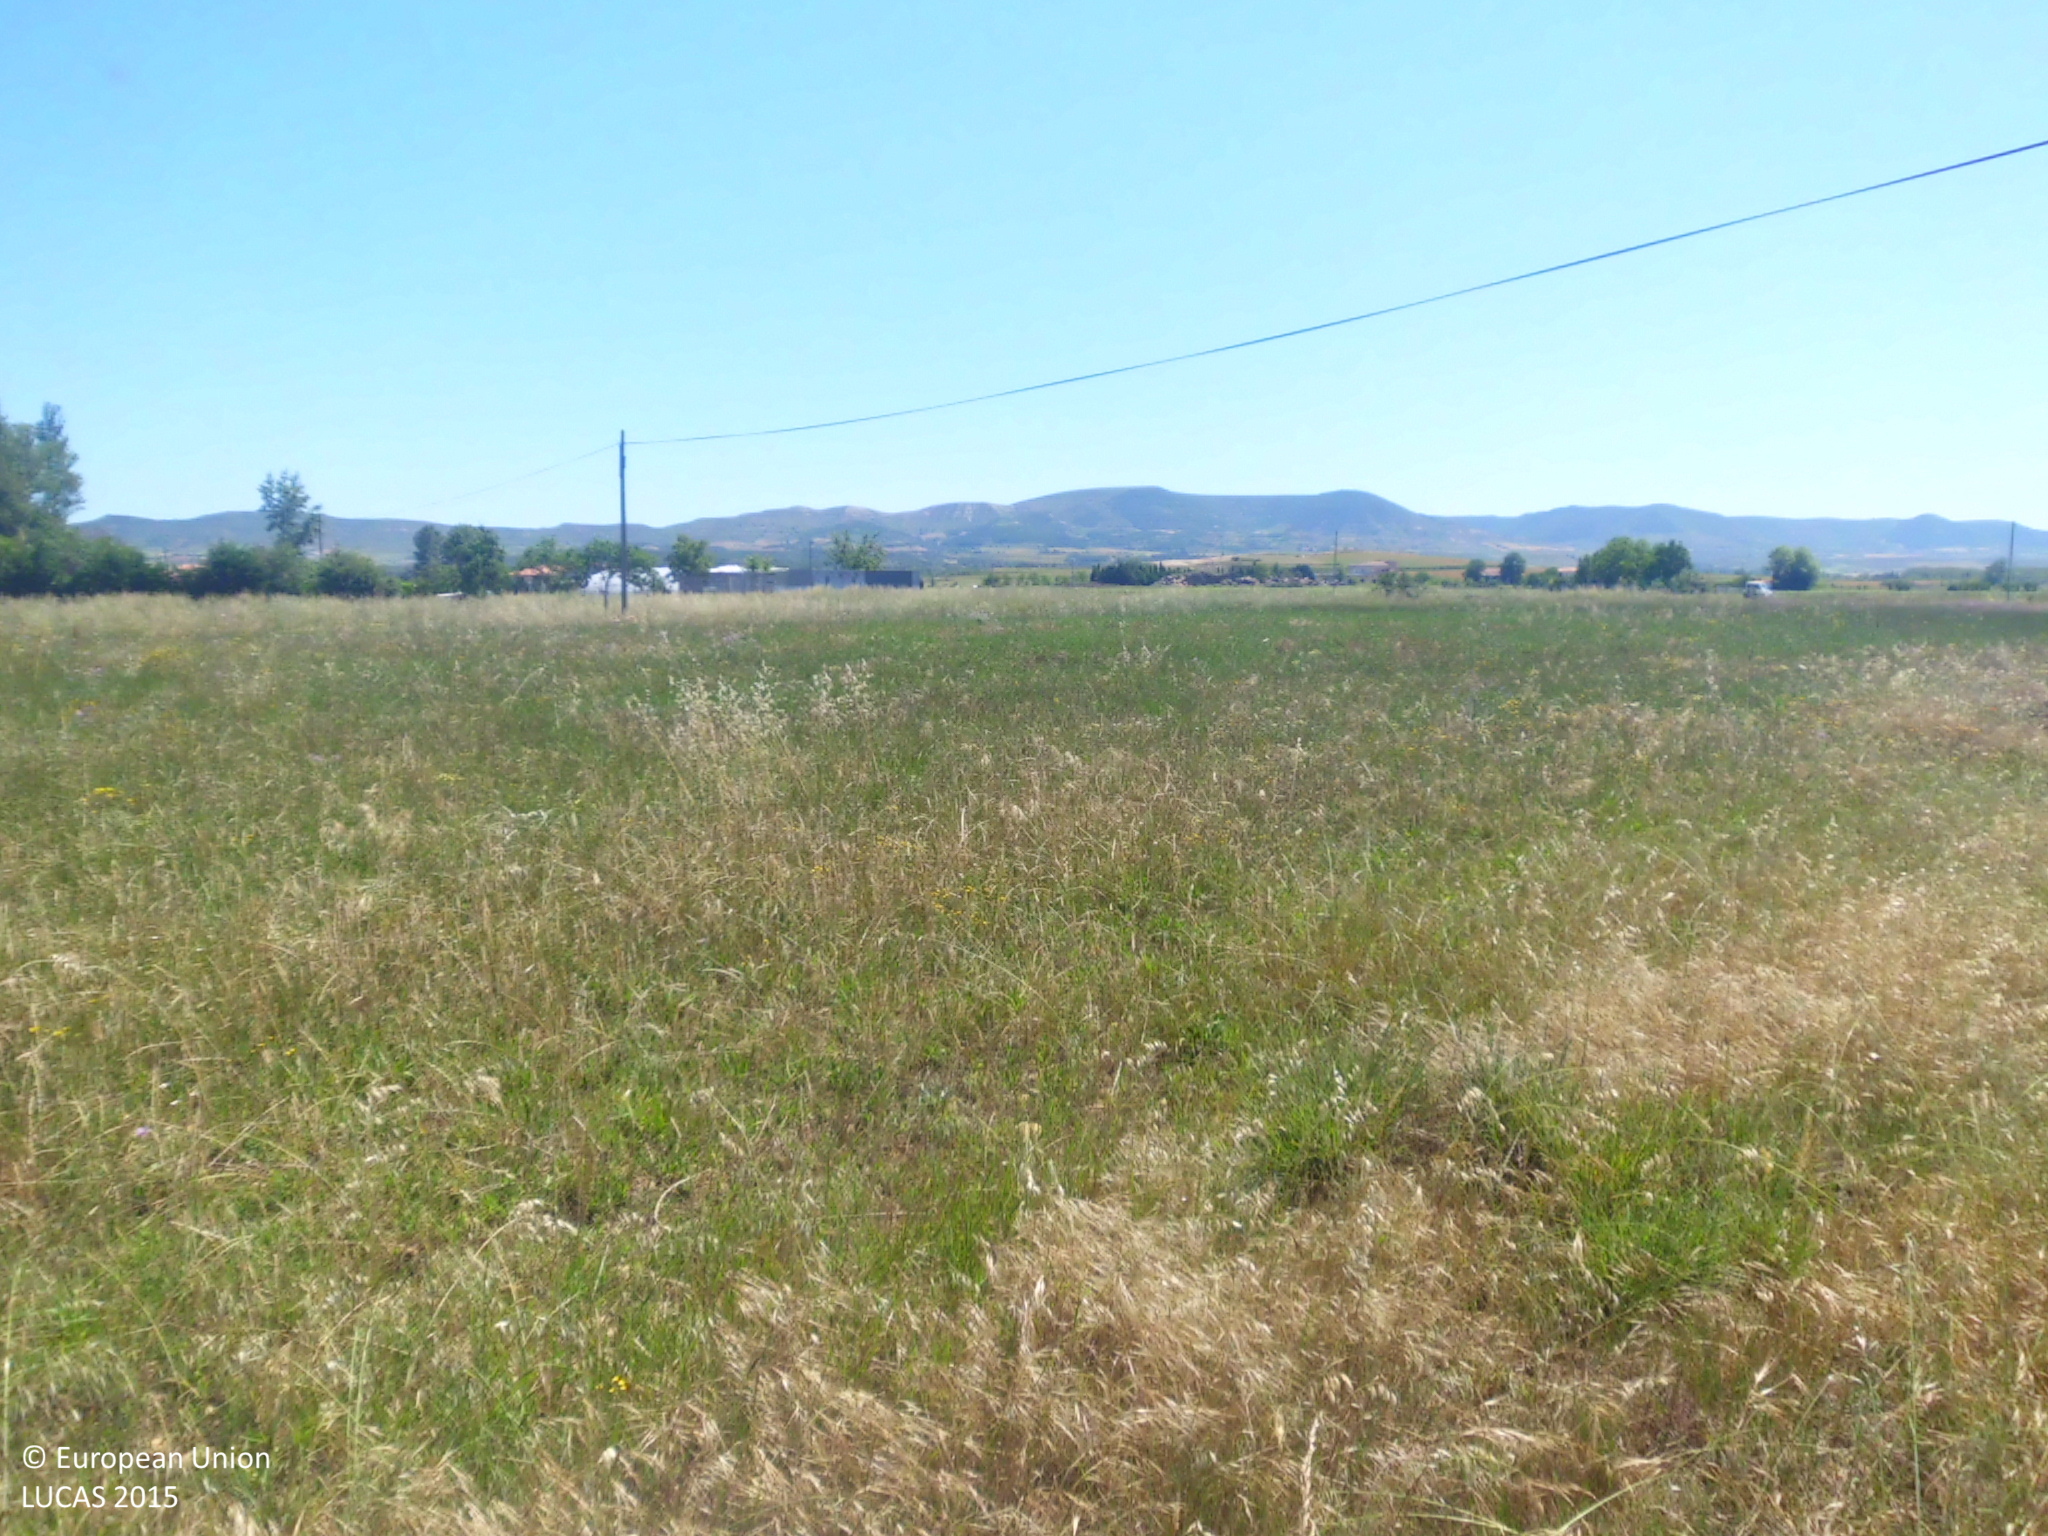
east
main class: Grassland
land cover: Grassland without tree/shrub cover
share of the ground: > 75 %
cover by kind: herbaceous plants 100 %
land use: Agriculture (excluding fallow land and kitchen gardens)
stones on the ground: 25 - 50 %
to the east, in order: Grassland without tree/shrub cover; Electric lines; Grassland without tree/shrub cover; Grass margins; Grassland without tree/shrub cover; Paved roads, cycling and walking lanes; Grass margins; Common wheat
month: June
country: ES
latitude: 42.9153
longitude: -3.5018
